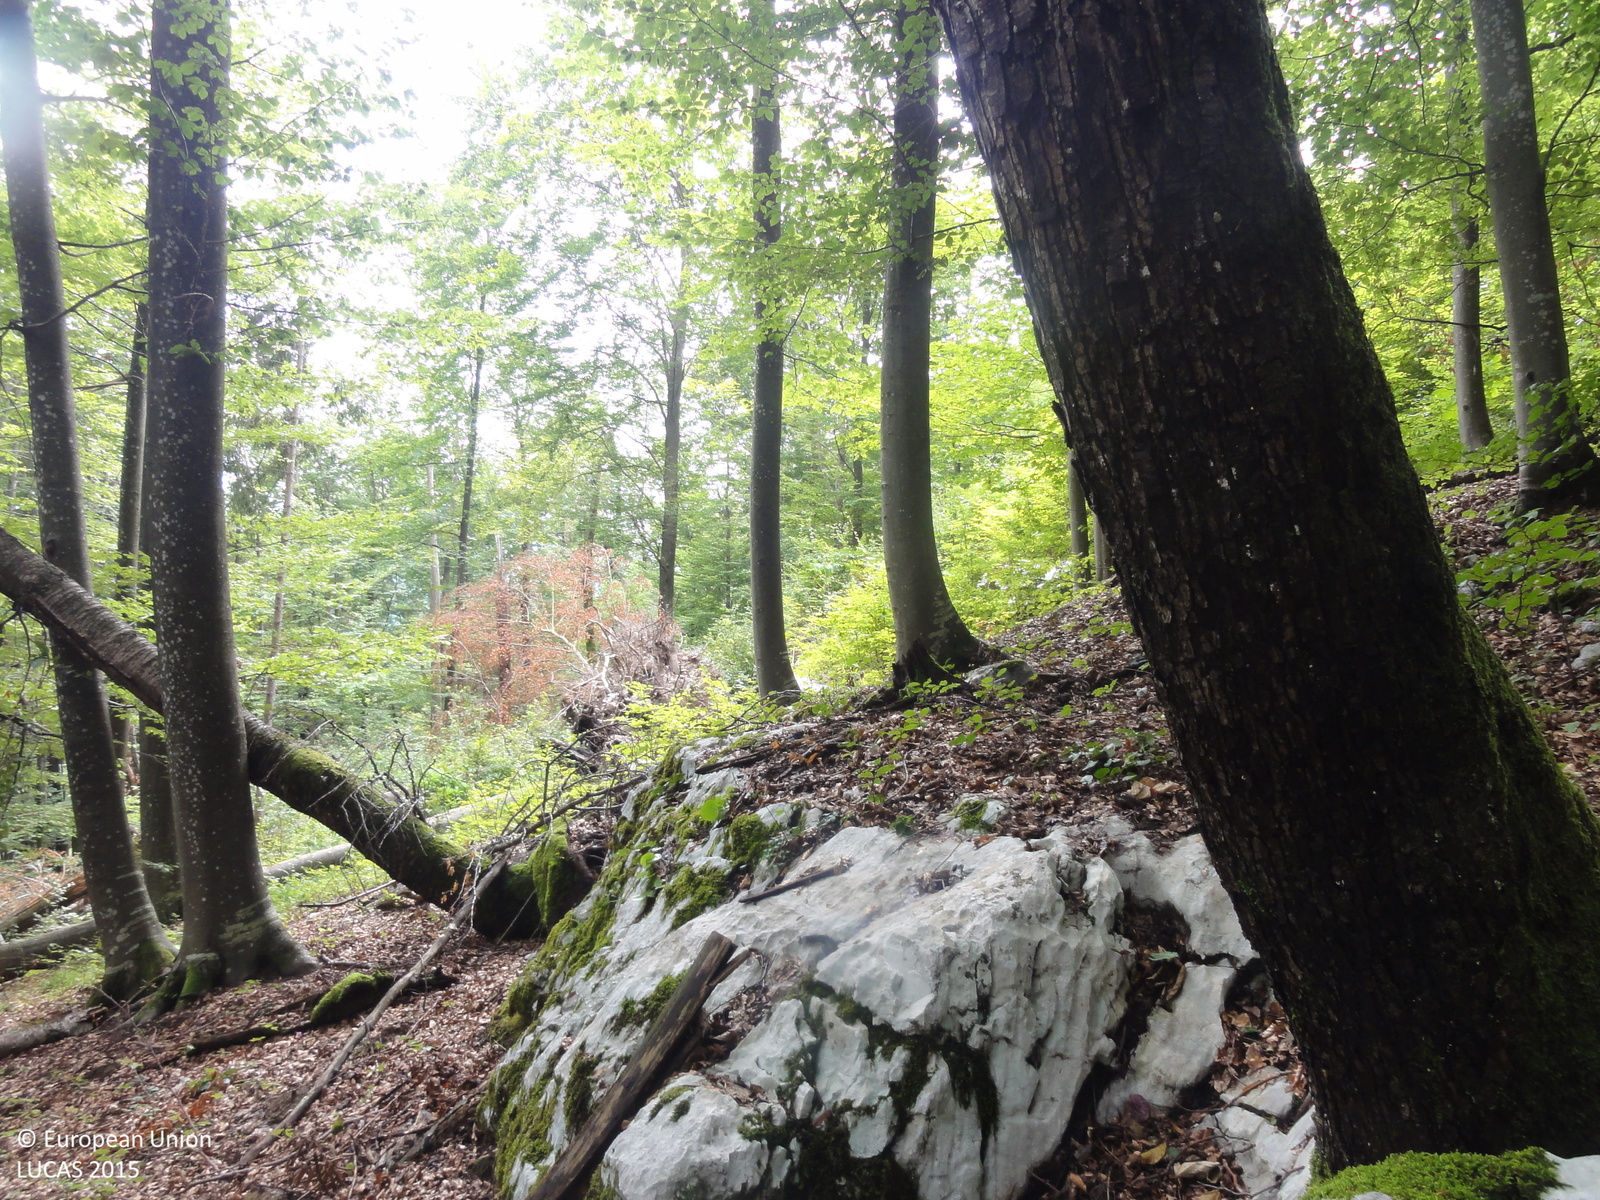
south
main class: Woodland
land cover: Broadleaved woodland
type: beech forest
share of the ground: > 75 %
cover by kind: broadleaved forest trees 95 %, shrubs 5 %
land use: Forestry
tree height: > 5 m
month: August
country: SI
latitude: 45.7640
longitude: 15.0237
